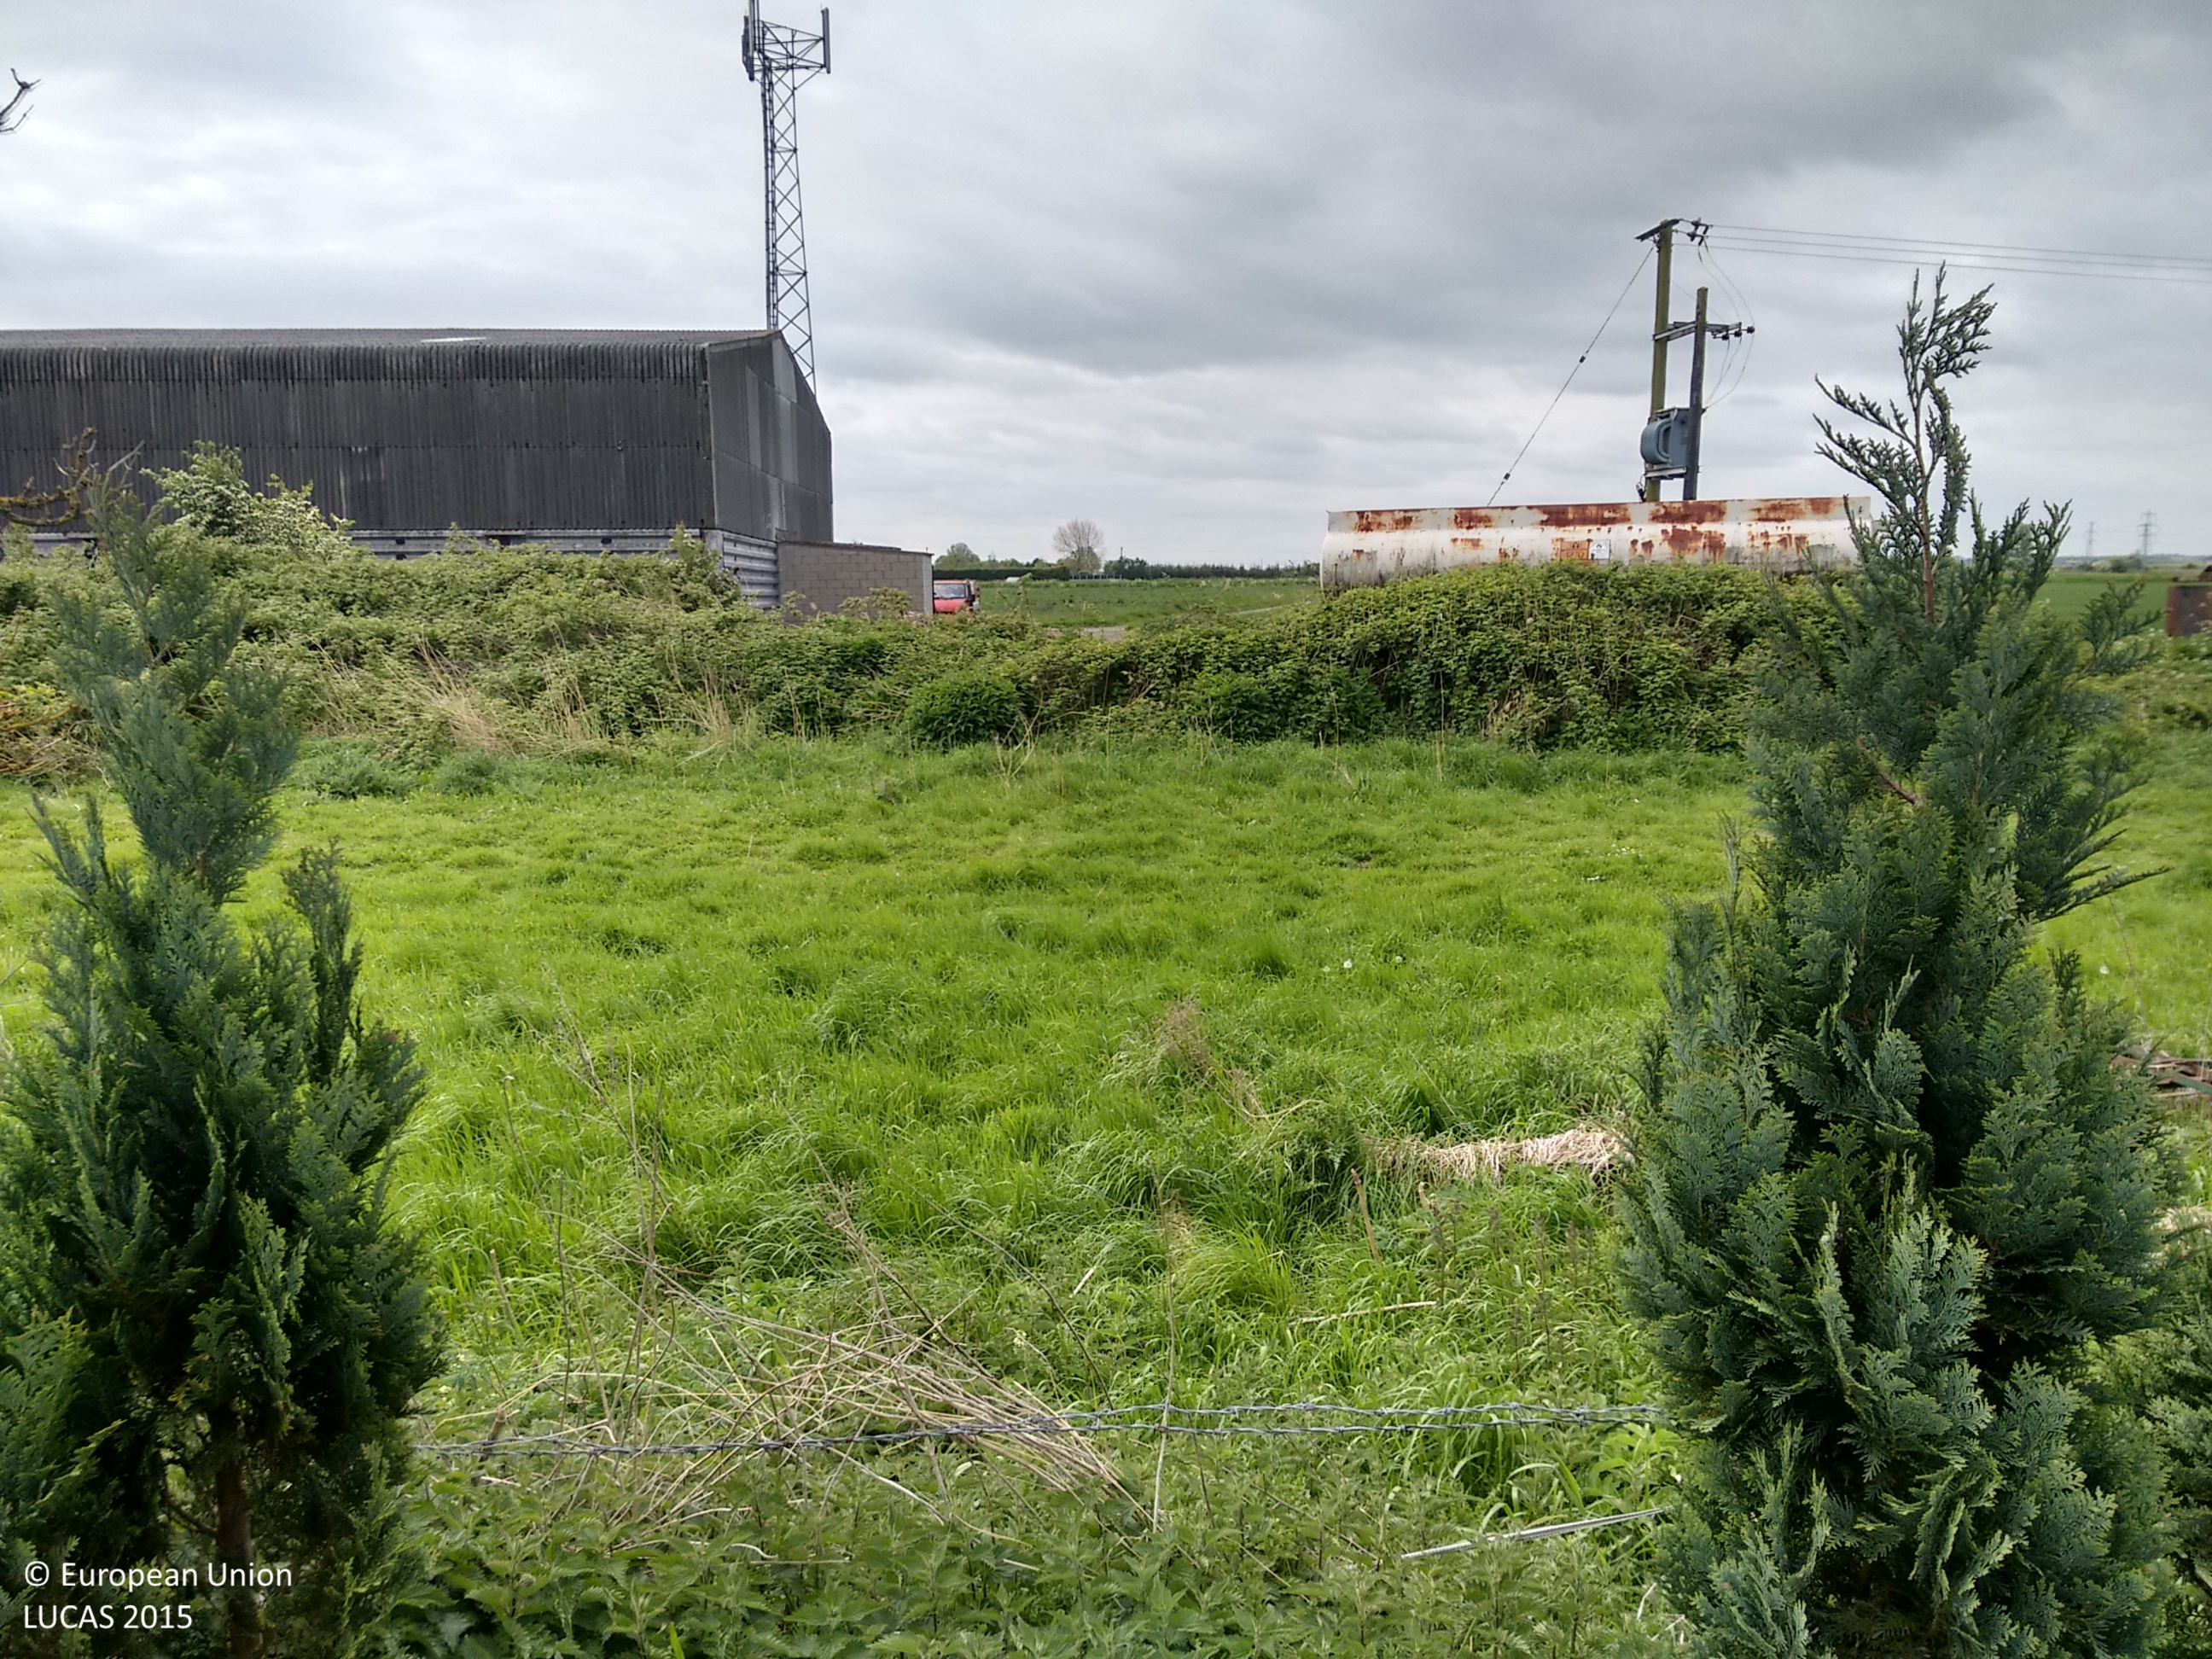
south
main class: Grassland
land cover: Grassland without tree/shrub cover
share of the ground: > 75 %
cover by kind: herbaceous plants 100 %
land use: Residential
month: May
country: GB
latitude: 53.5753
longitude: -0.7476
